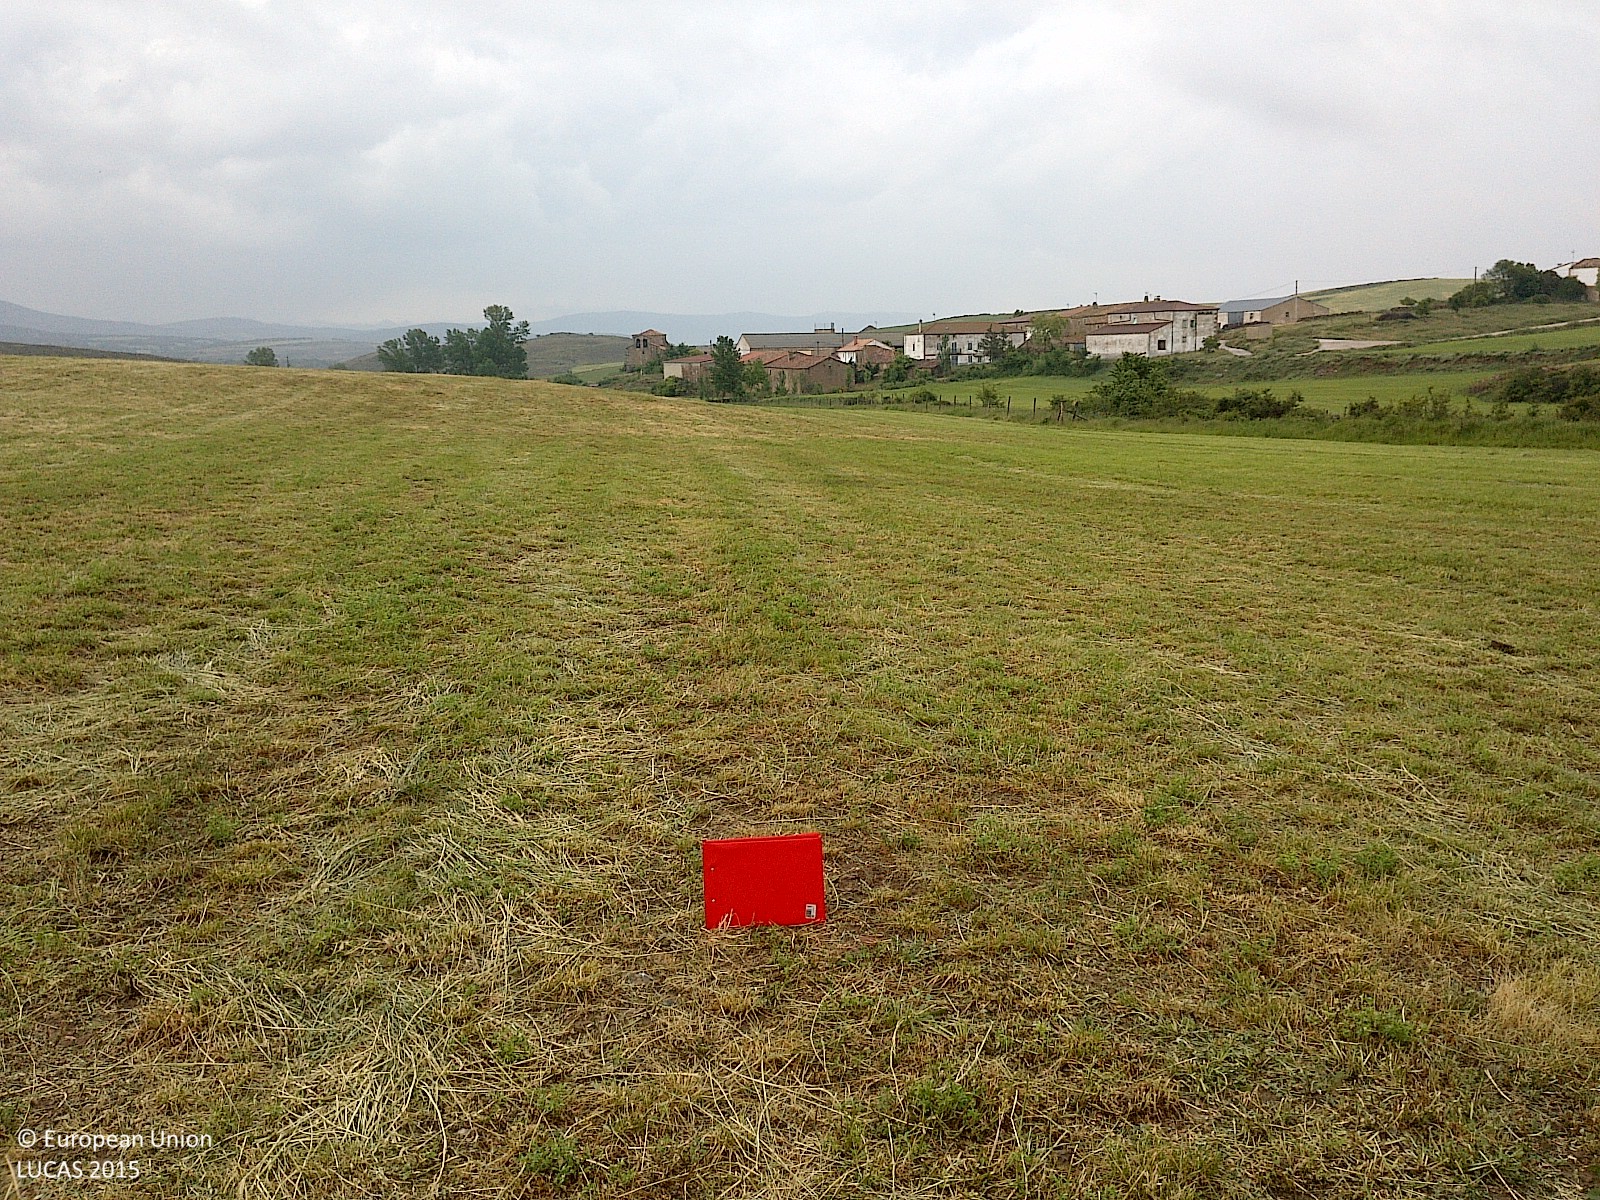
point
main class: Cropland
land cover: Lucerne
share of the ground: > 75 %
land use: Agriculture (excluding fallow land and kitchen gardens)
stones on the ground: < 10 %
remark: Harvested field
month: May
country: ES
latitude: 41.7622
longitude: -2.2440
